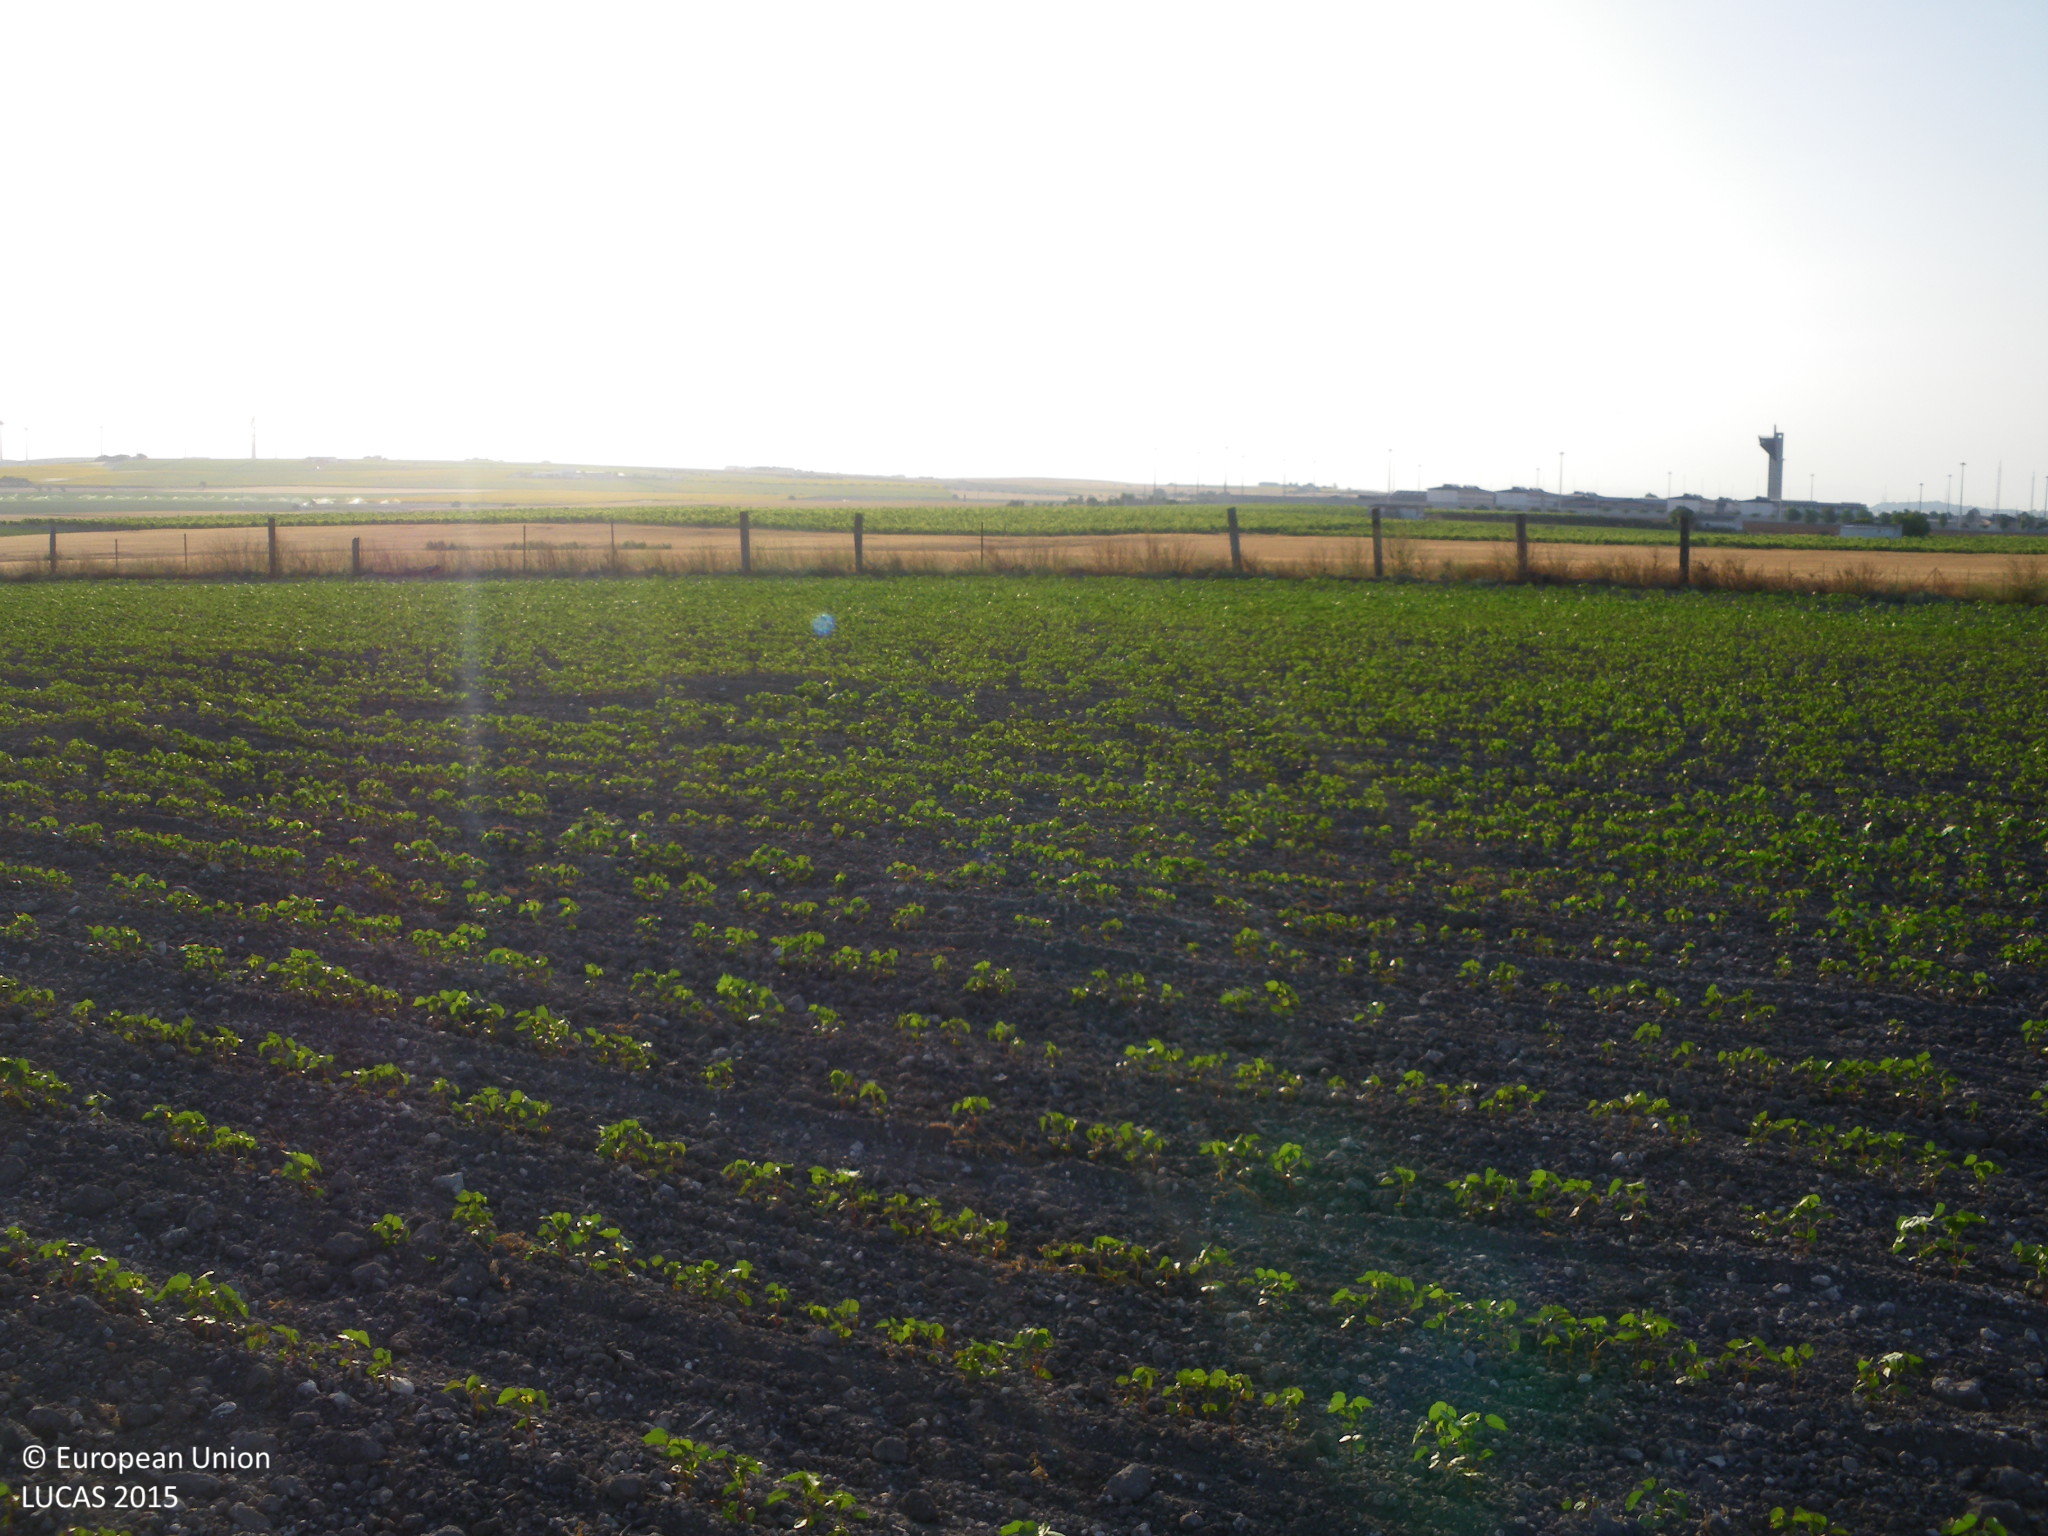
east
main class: Cropland
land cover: Cotton
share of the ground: 10 - 25 %
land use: Agriculture (excluding fallow land and kitchen gardens)
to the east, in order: Cotton; Grass margins; Fences; Grass margins; Tracks; Grass margins; Durum wheat
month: June
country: ES
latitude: 36.6682
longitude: -6.2711
